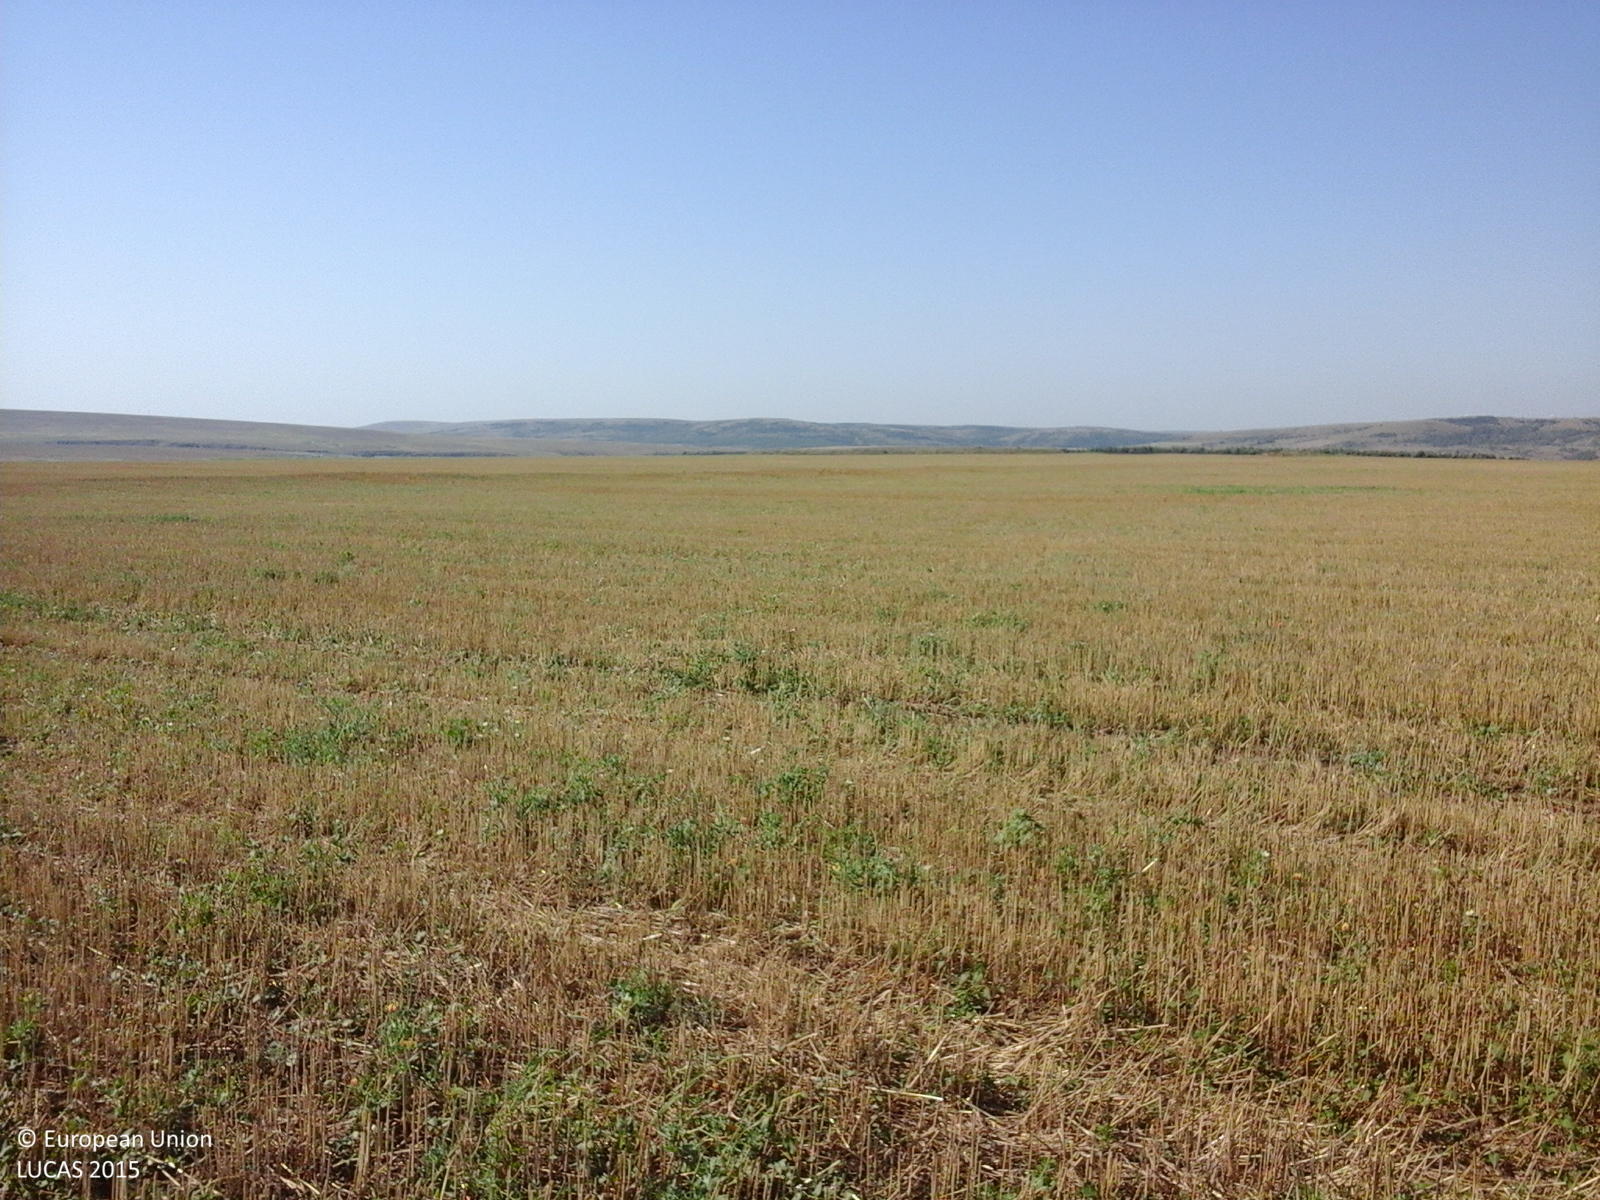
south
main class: Cropland
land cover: Common wheat
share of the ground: > 75 %
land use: Agriculture (excluding fallow land and kitchen gardens)
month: August
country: RO
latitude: 44.5152
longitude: 28.5035
